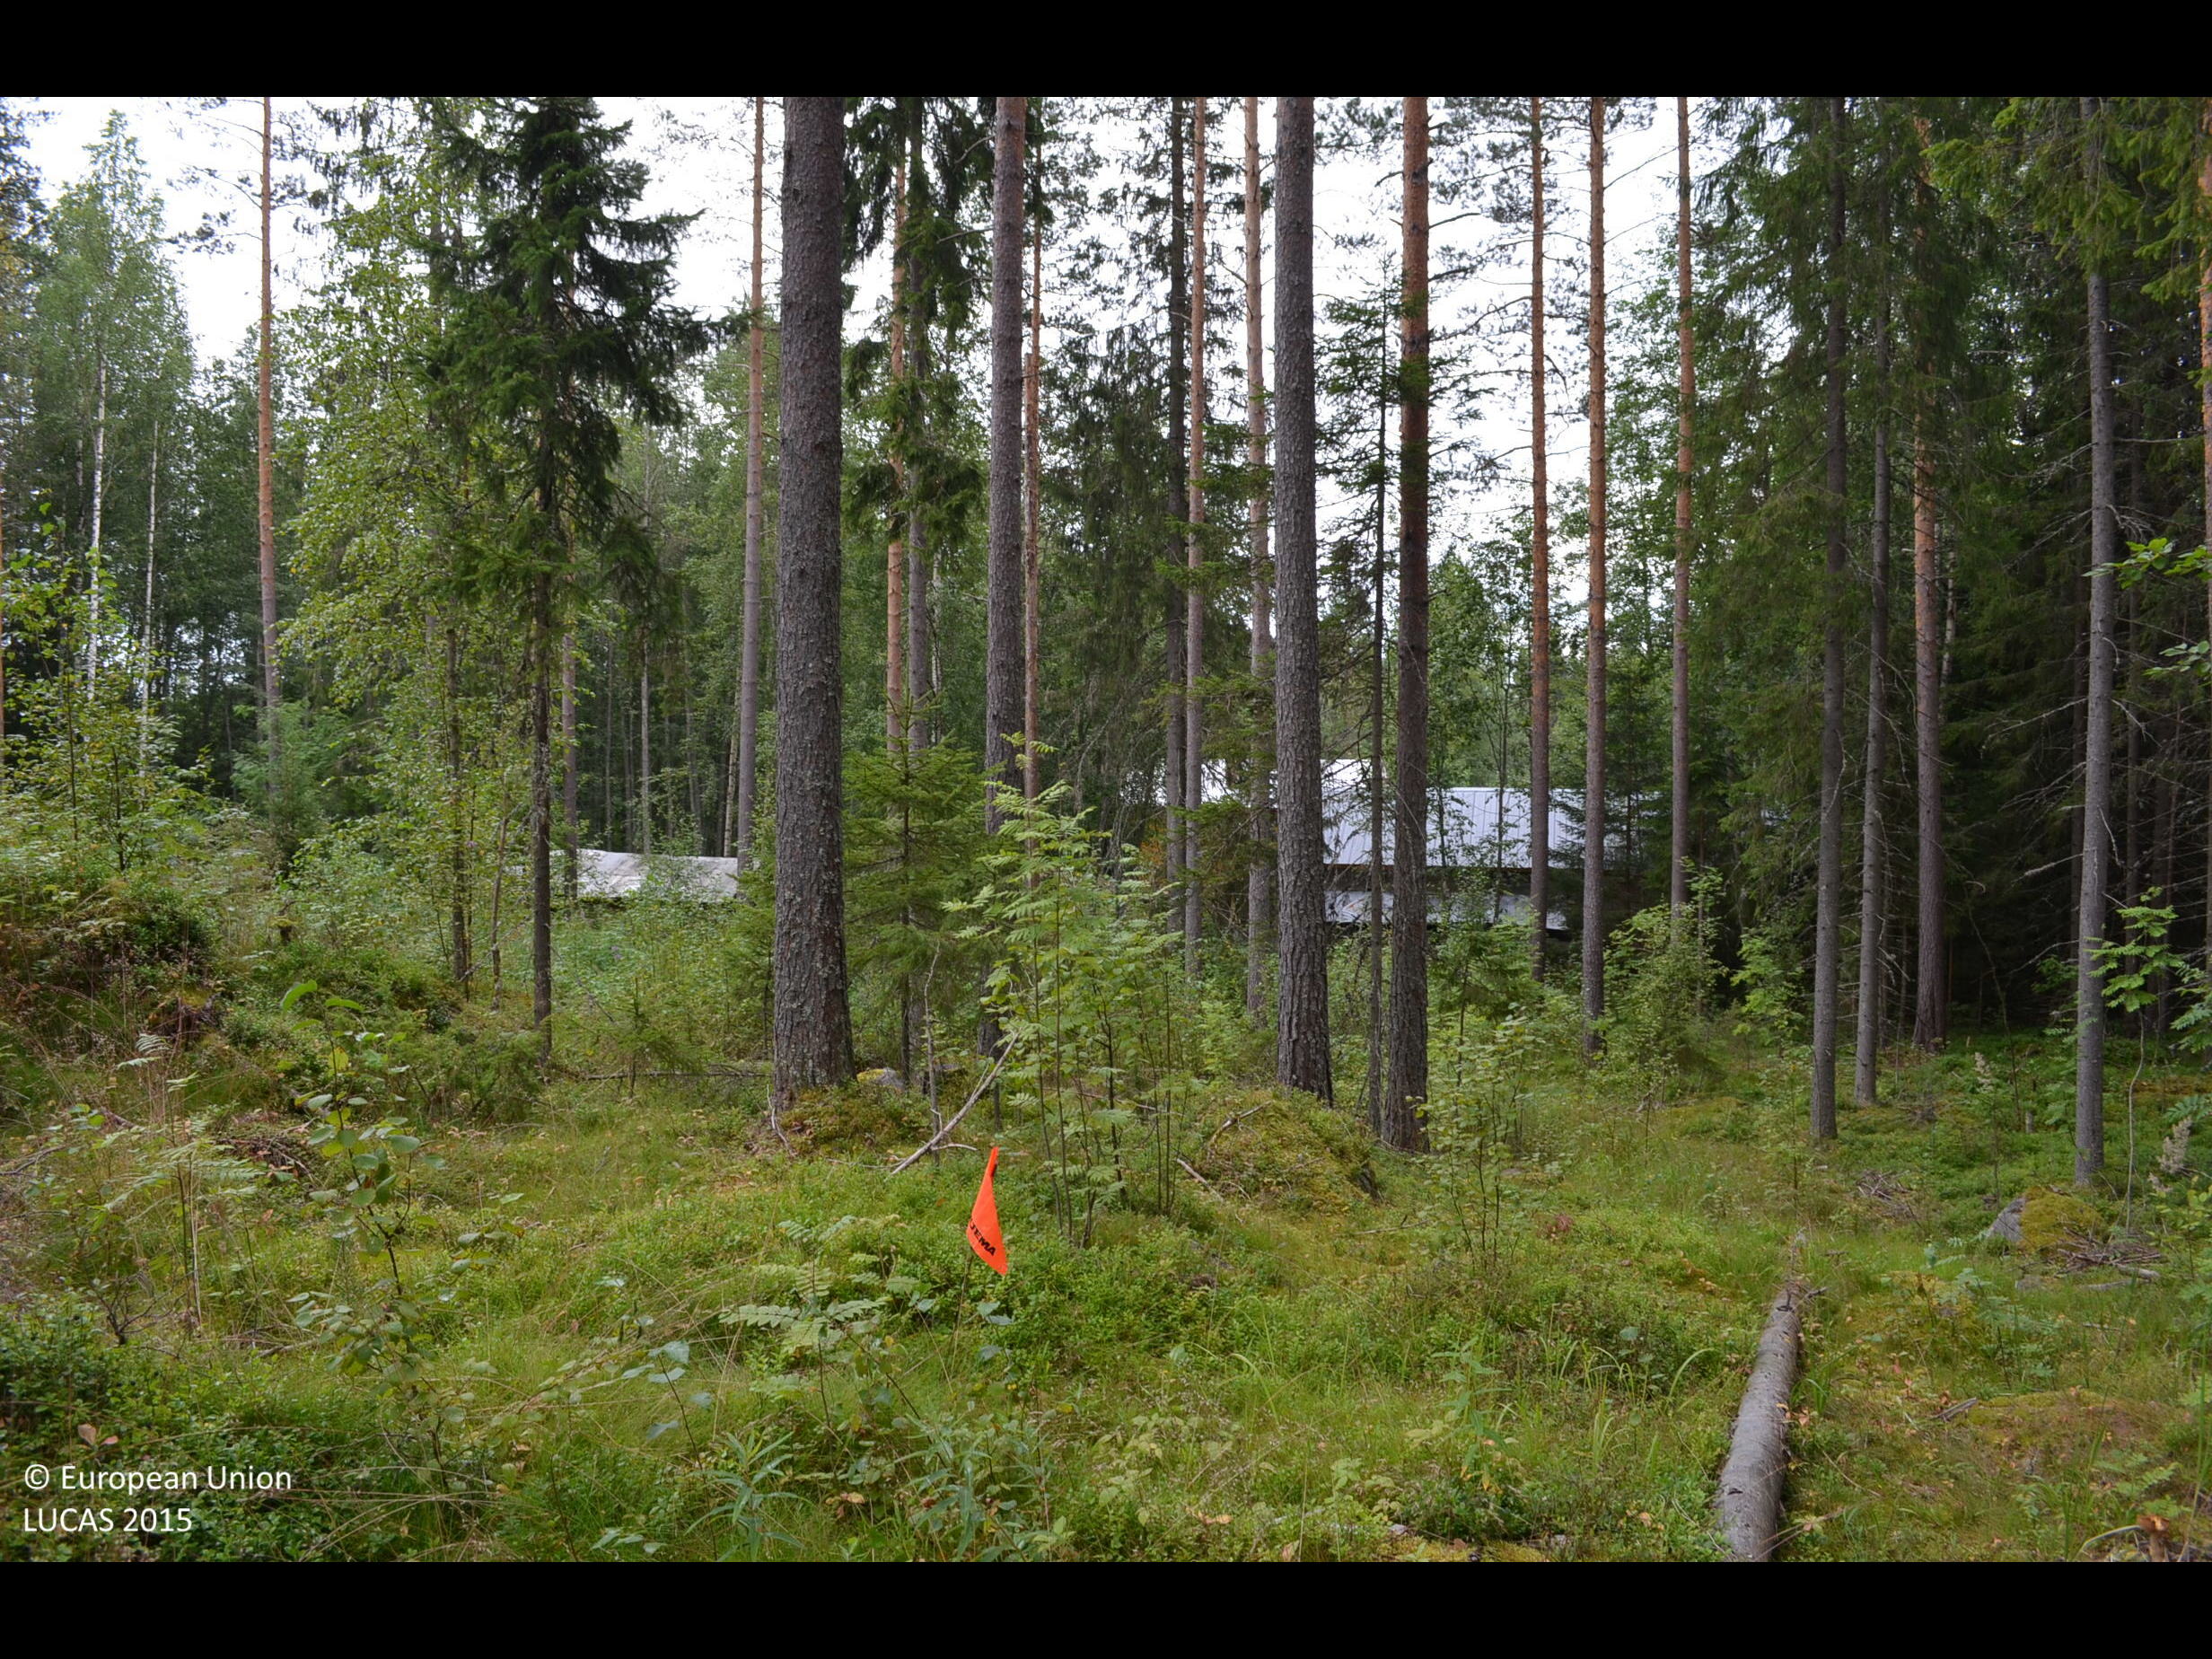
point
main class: Woodland
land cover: Pine dominated coniferous woodland
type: boreal forest
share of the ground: 50 - 75 %
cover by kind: coniferous forest trees 45 %, shrubs 30 %, broadleaved forest trees 10 %, herbaceous plants 10 %
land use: Forestry
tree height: > 5 m
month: August
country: FI
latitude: 62.2086
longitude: 24.2173
